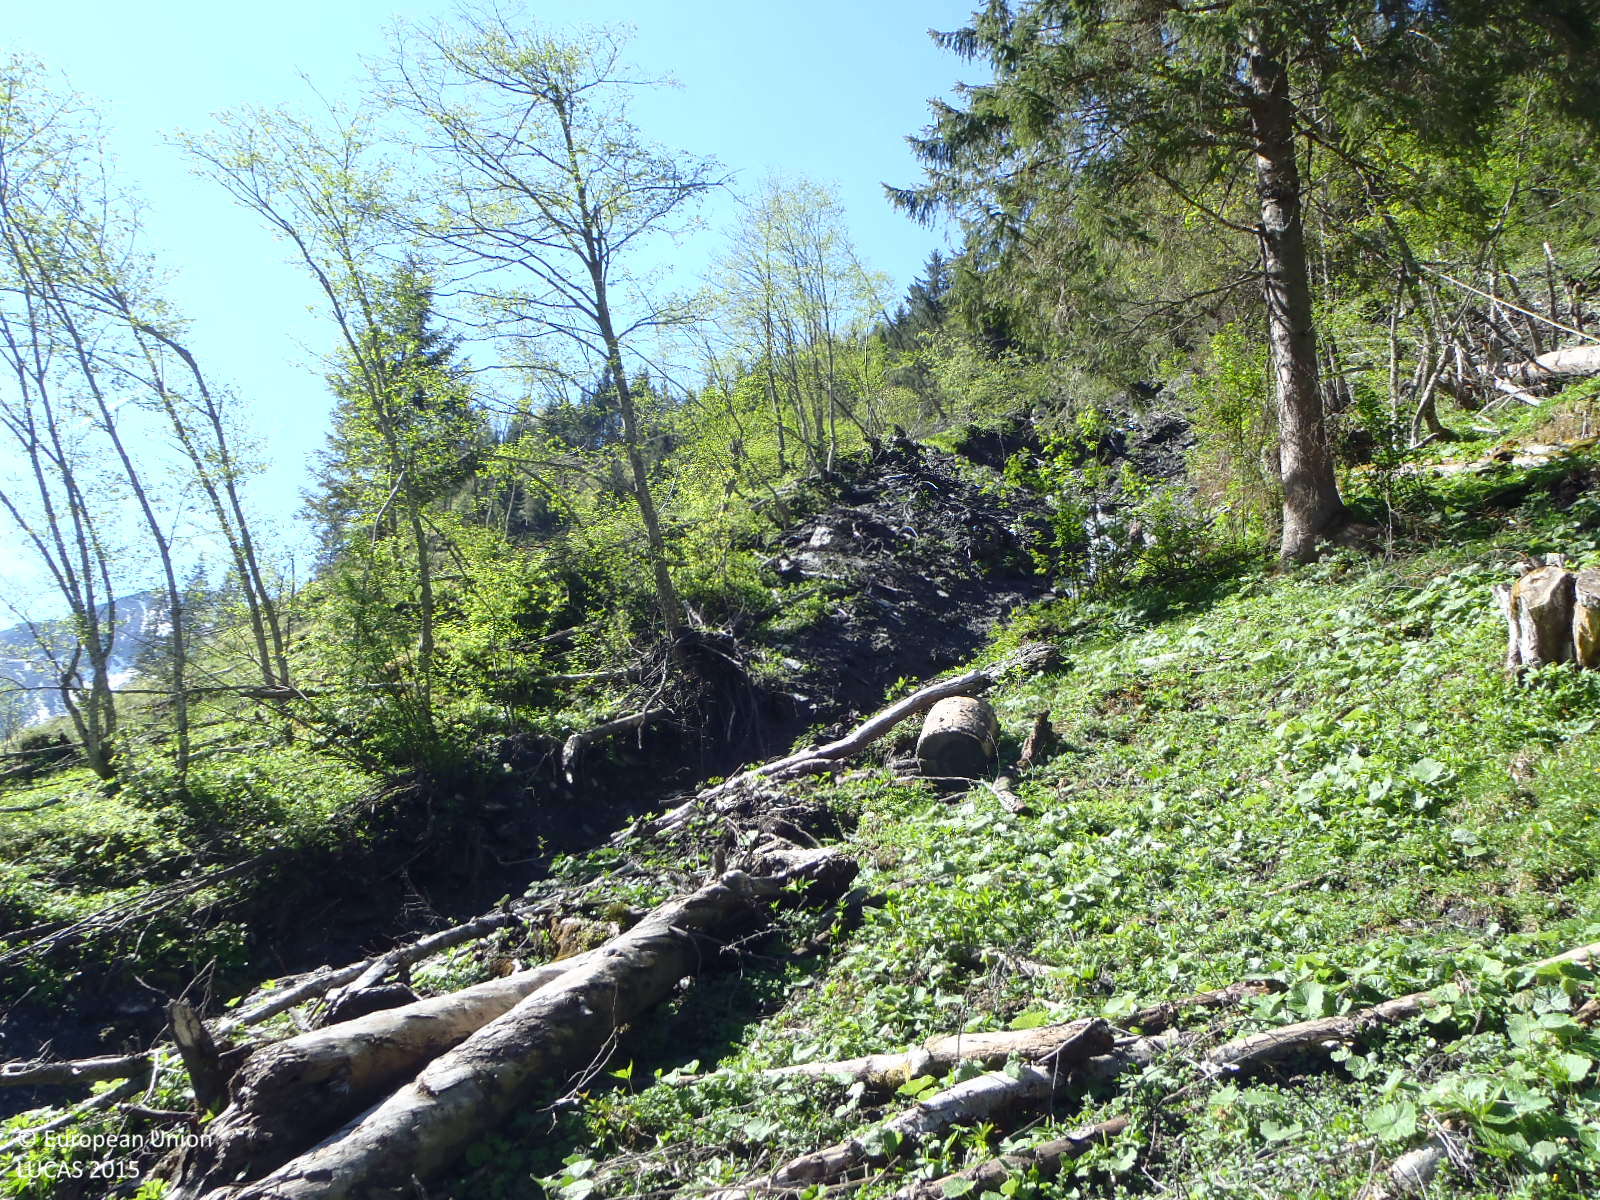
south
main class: Woodland
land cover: Broadleaved woodland
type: mountainous beech forest
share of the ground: 10 - 25 %
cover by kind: herbaceous plants 55 %, broadleaved forest trees 25 %, shrubs 10 %, coniferous forest trees 5 %, unconsolidated bare surface 5 %
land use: Forestry
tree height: > 5 m
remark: Clear cut
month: May
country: AT
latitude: 47.1479
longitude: 13.2816
